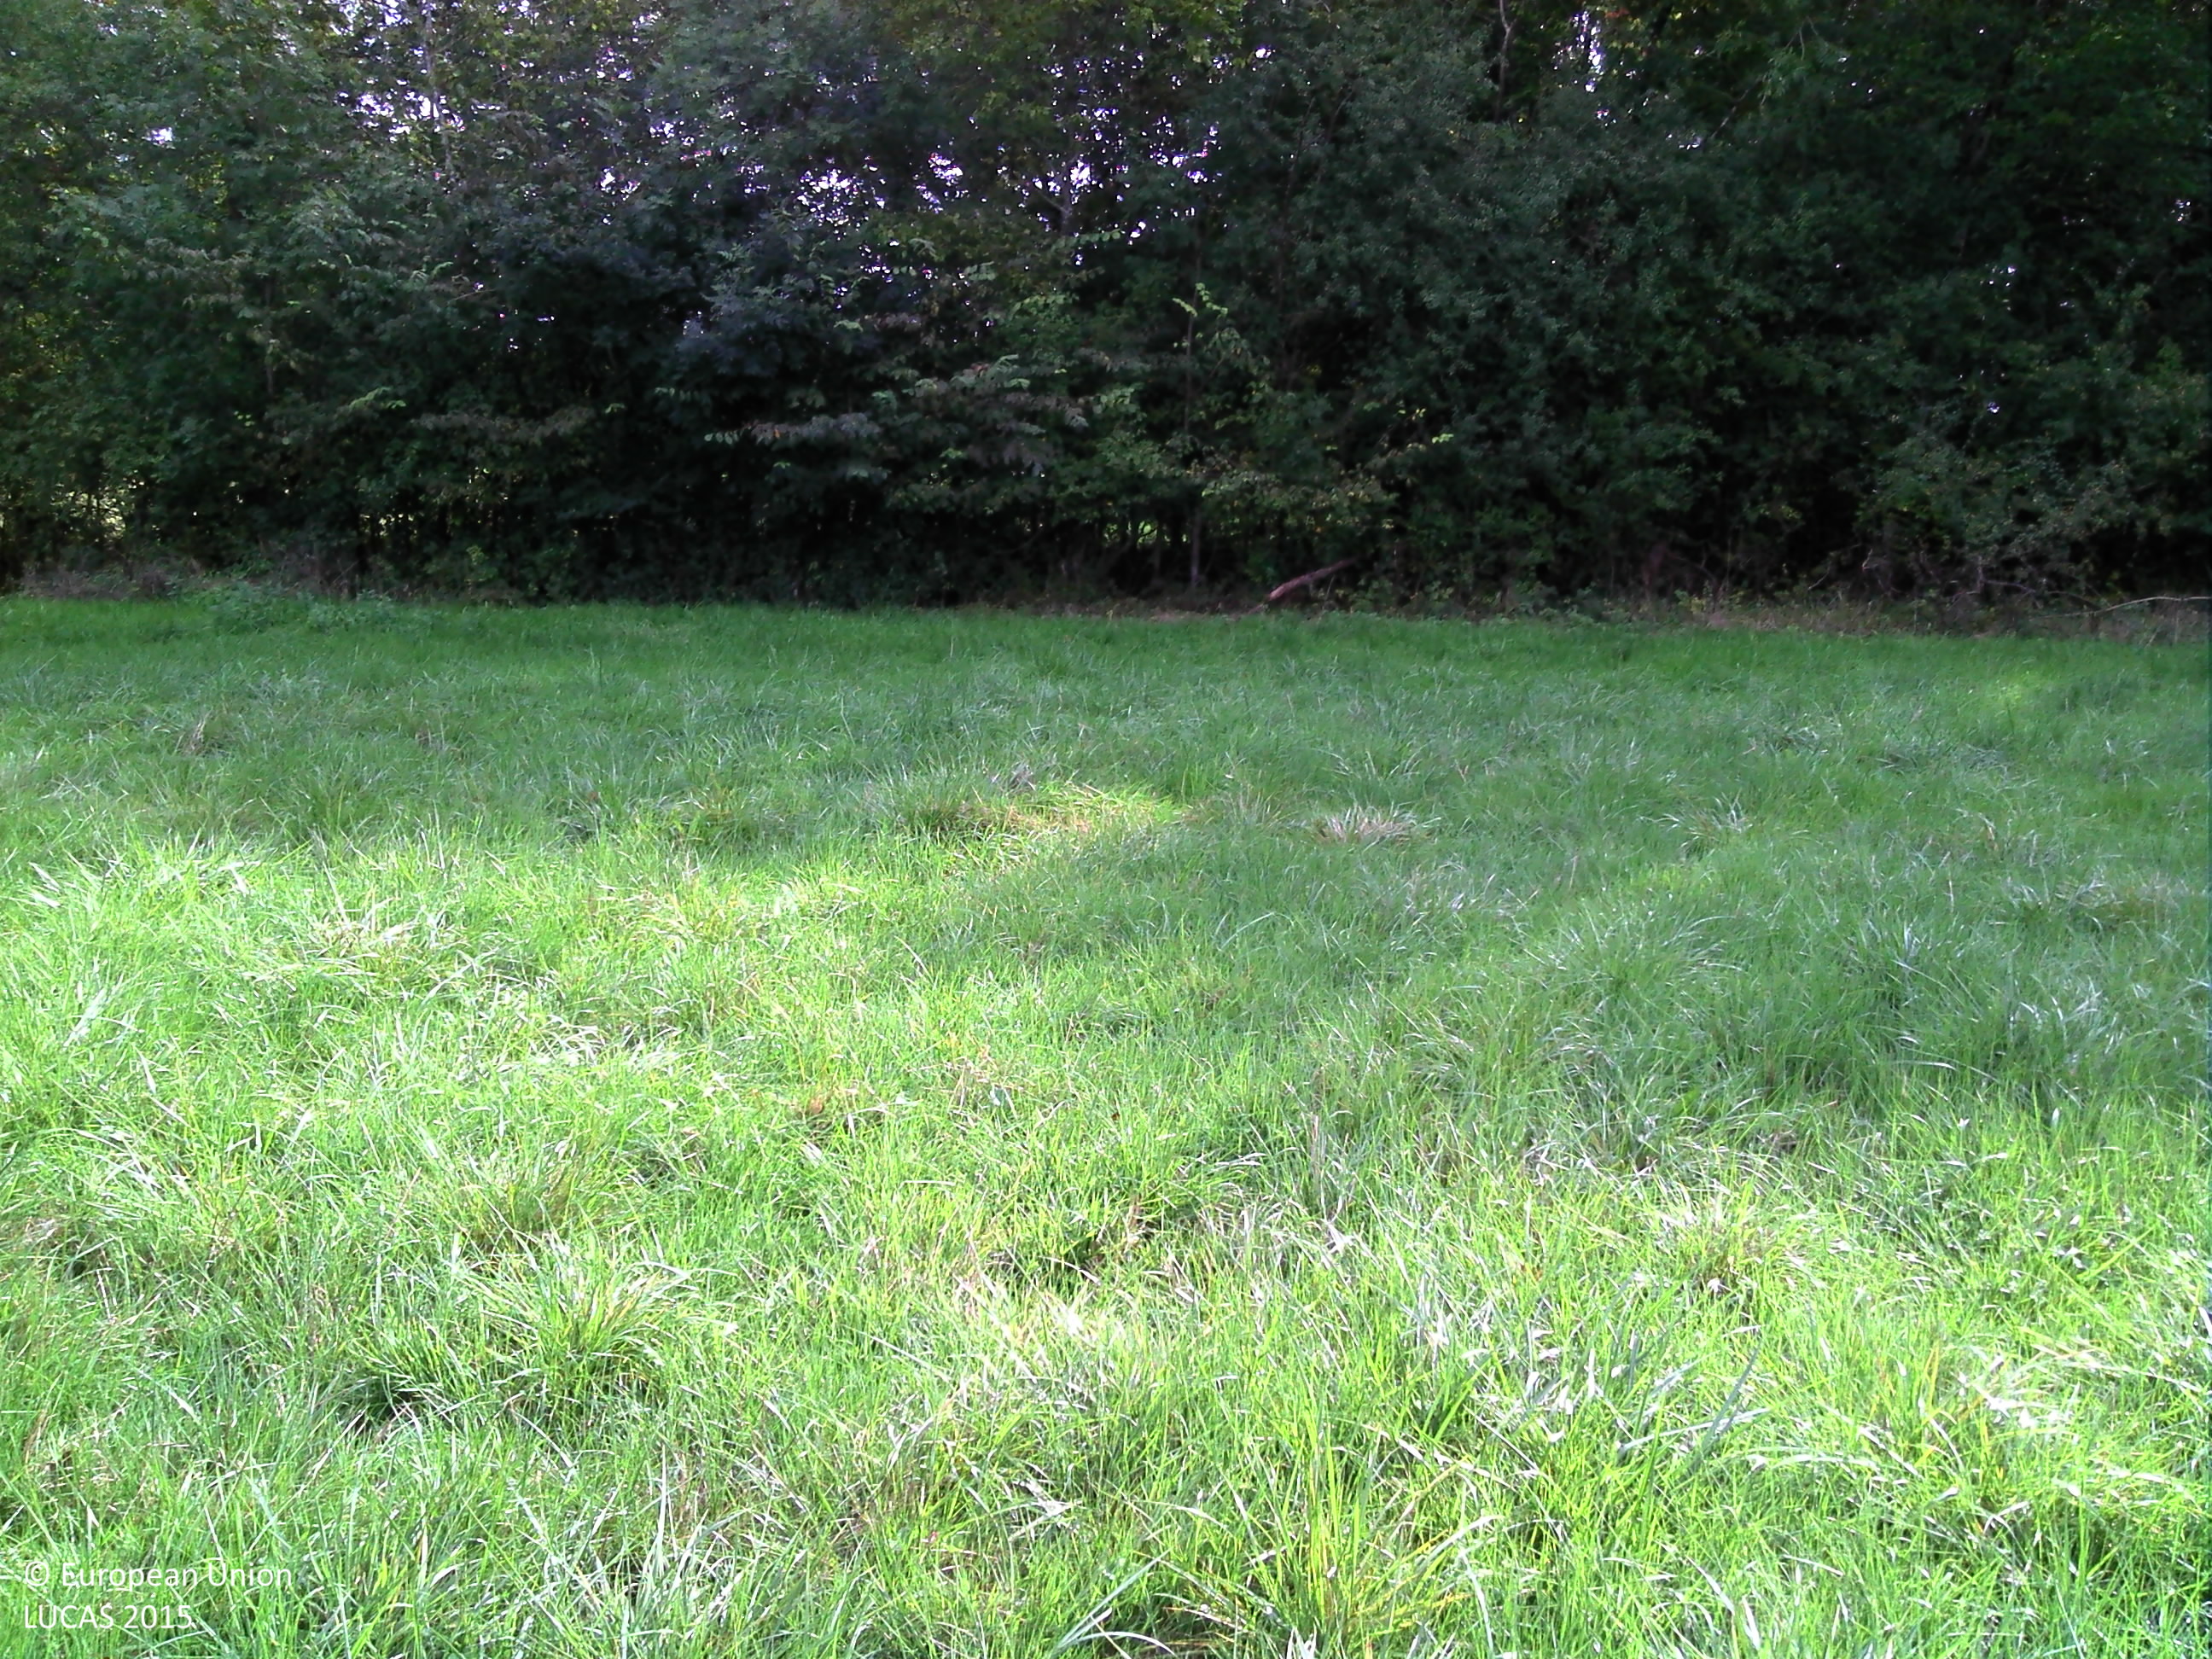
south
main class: Grassland
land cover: Grassland without tree/shrub cover
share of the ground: > 75 %
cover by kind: herbaceous plants 100 %
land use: Agriculture (excluding fallow land and kitchen gardens)
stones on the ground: < 10 %
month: September
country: FR
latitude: 48.5072
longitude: 4.6239
